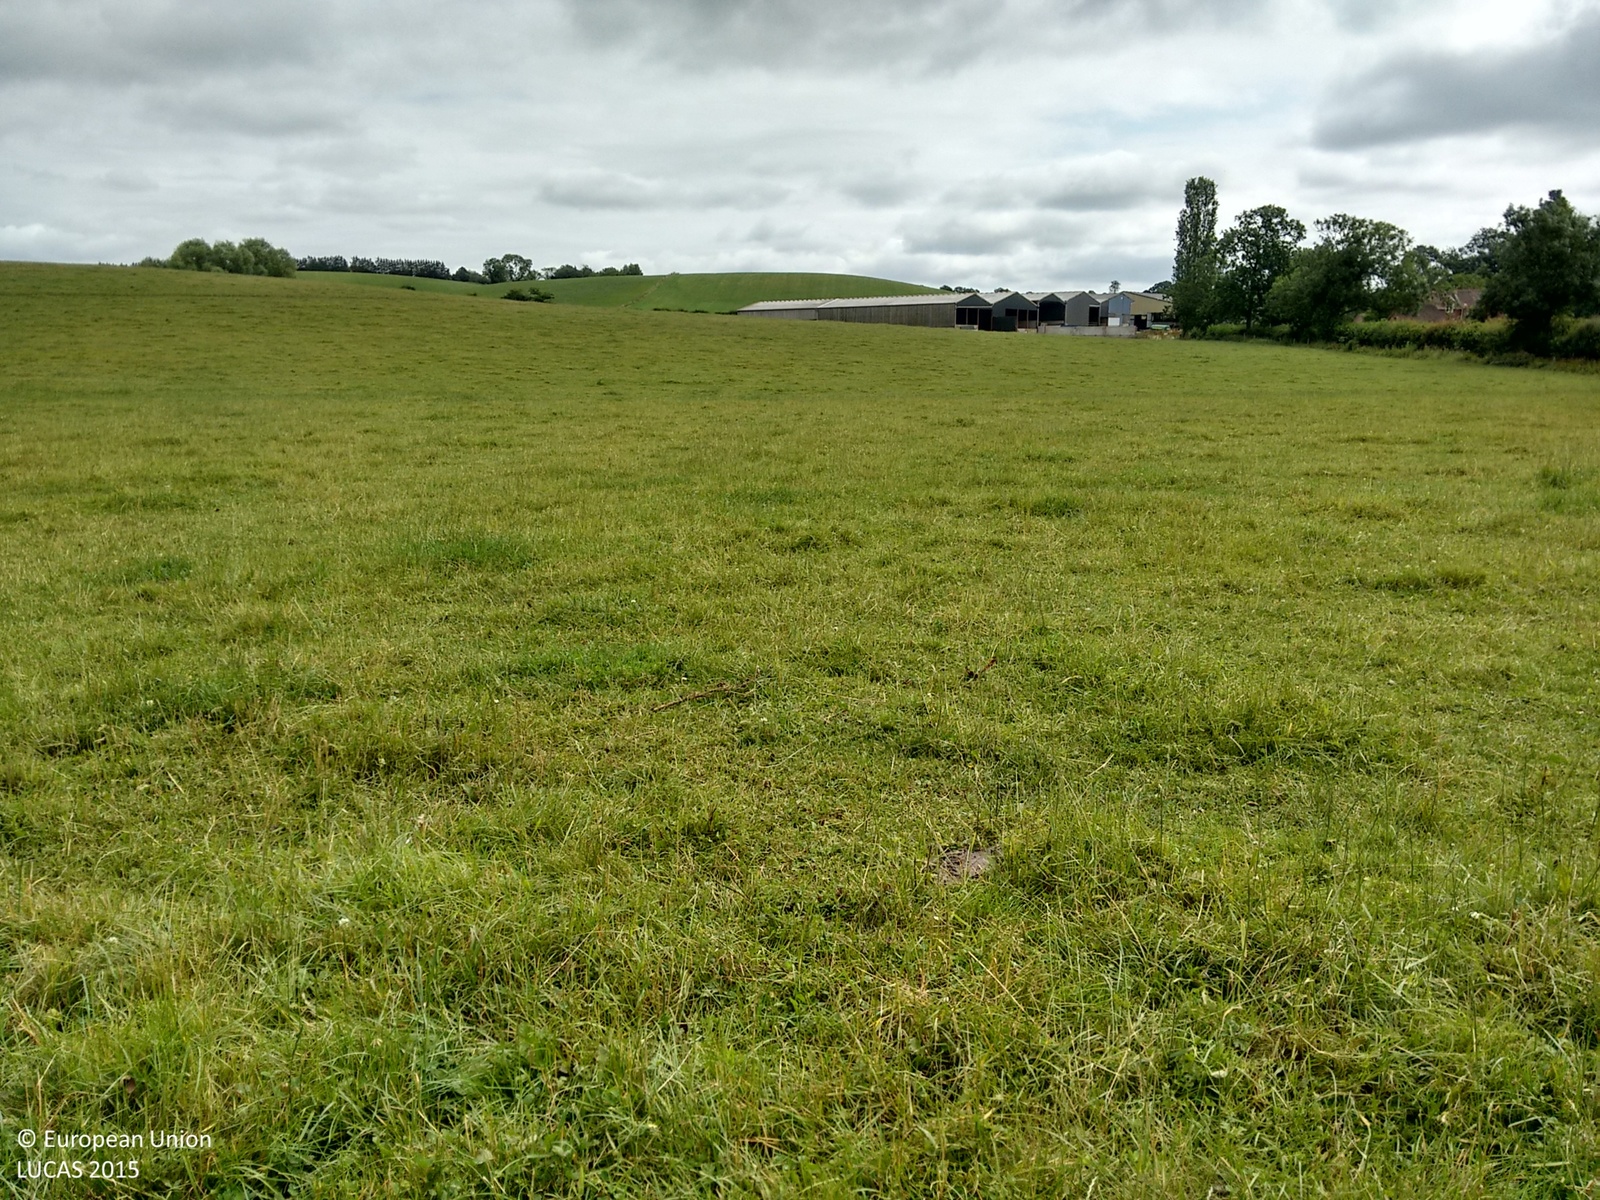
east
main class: Grassland
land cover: Grassland without tree/shrub cover
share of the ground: > 75 %
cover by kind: herbaceous plants 100 %
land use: Agriculture (excluding fallow land and kitchen gardens)
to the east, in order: Grassland without tree/shrub cover; Fences; Ditches and canals; Managed hedges; Fences; Grassland without tree/shrub cover; Fences; Managed hedges; Grassland without tree/shrub cover
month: July
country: GB
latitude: 52.1438
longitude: -2.5614
